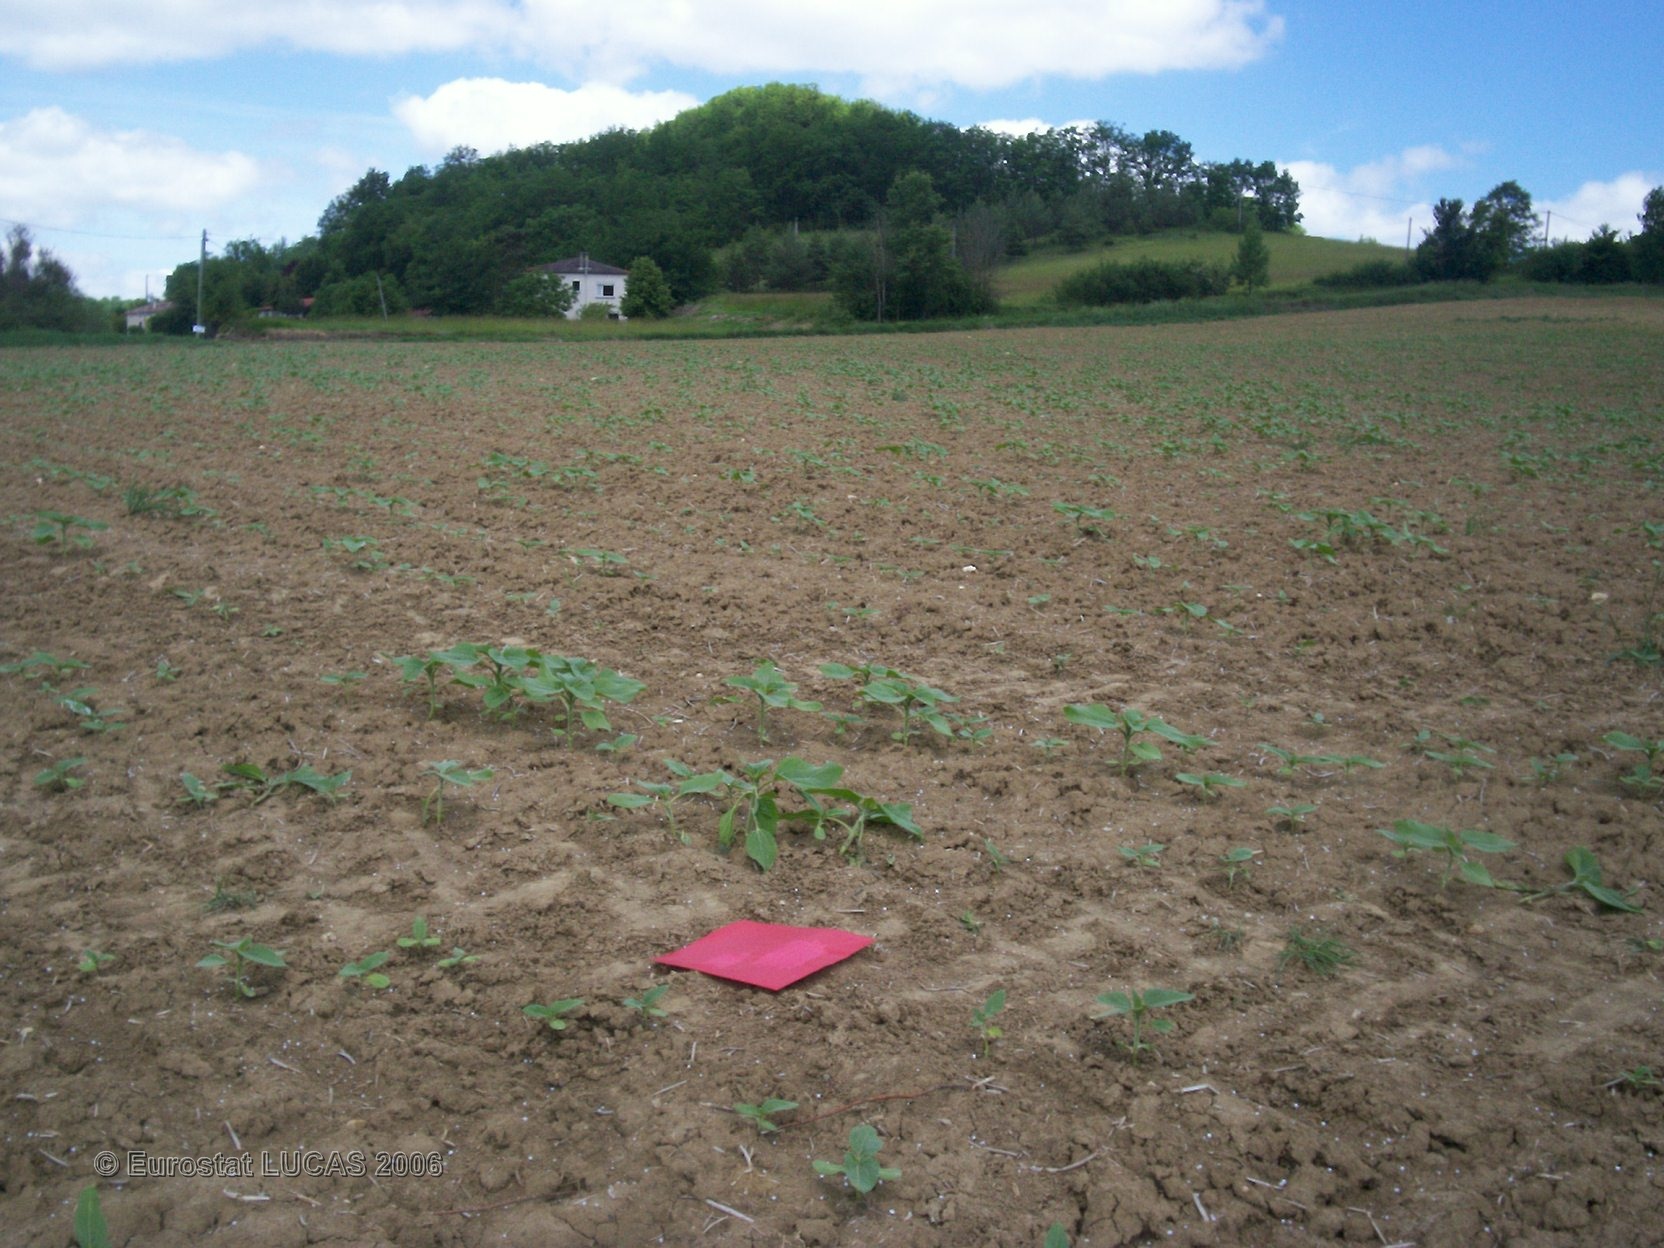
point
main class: Cropland
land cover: Sunflower
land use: Agriculture (excluding fallow land and kitchen gardens)
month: May
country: FR
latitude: 44.2933
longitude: 0.8845
